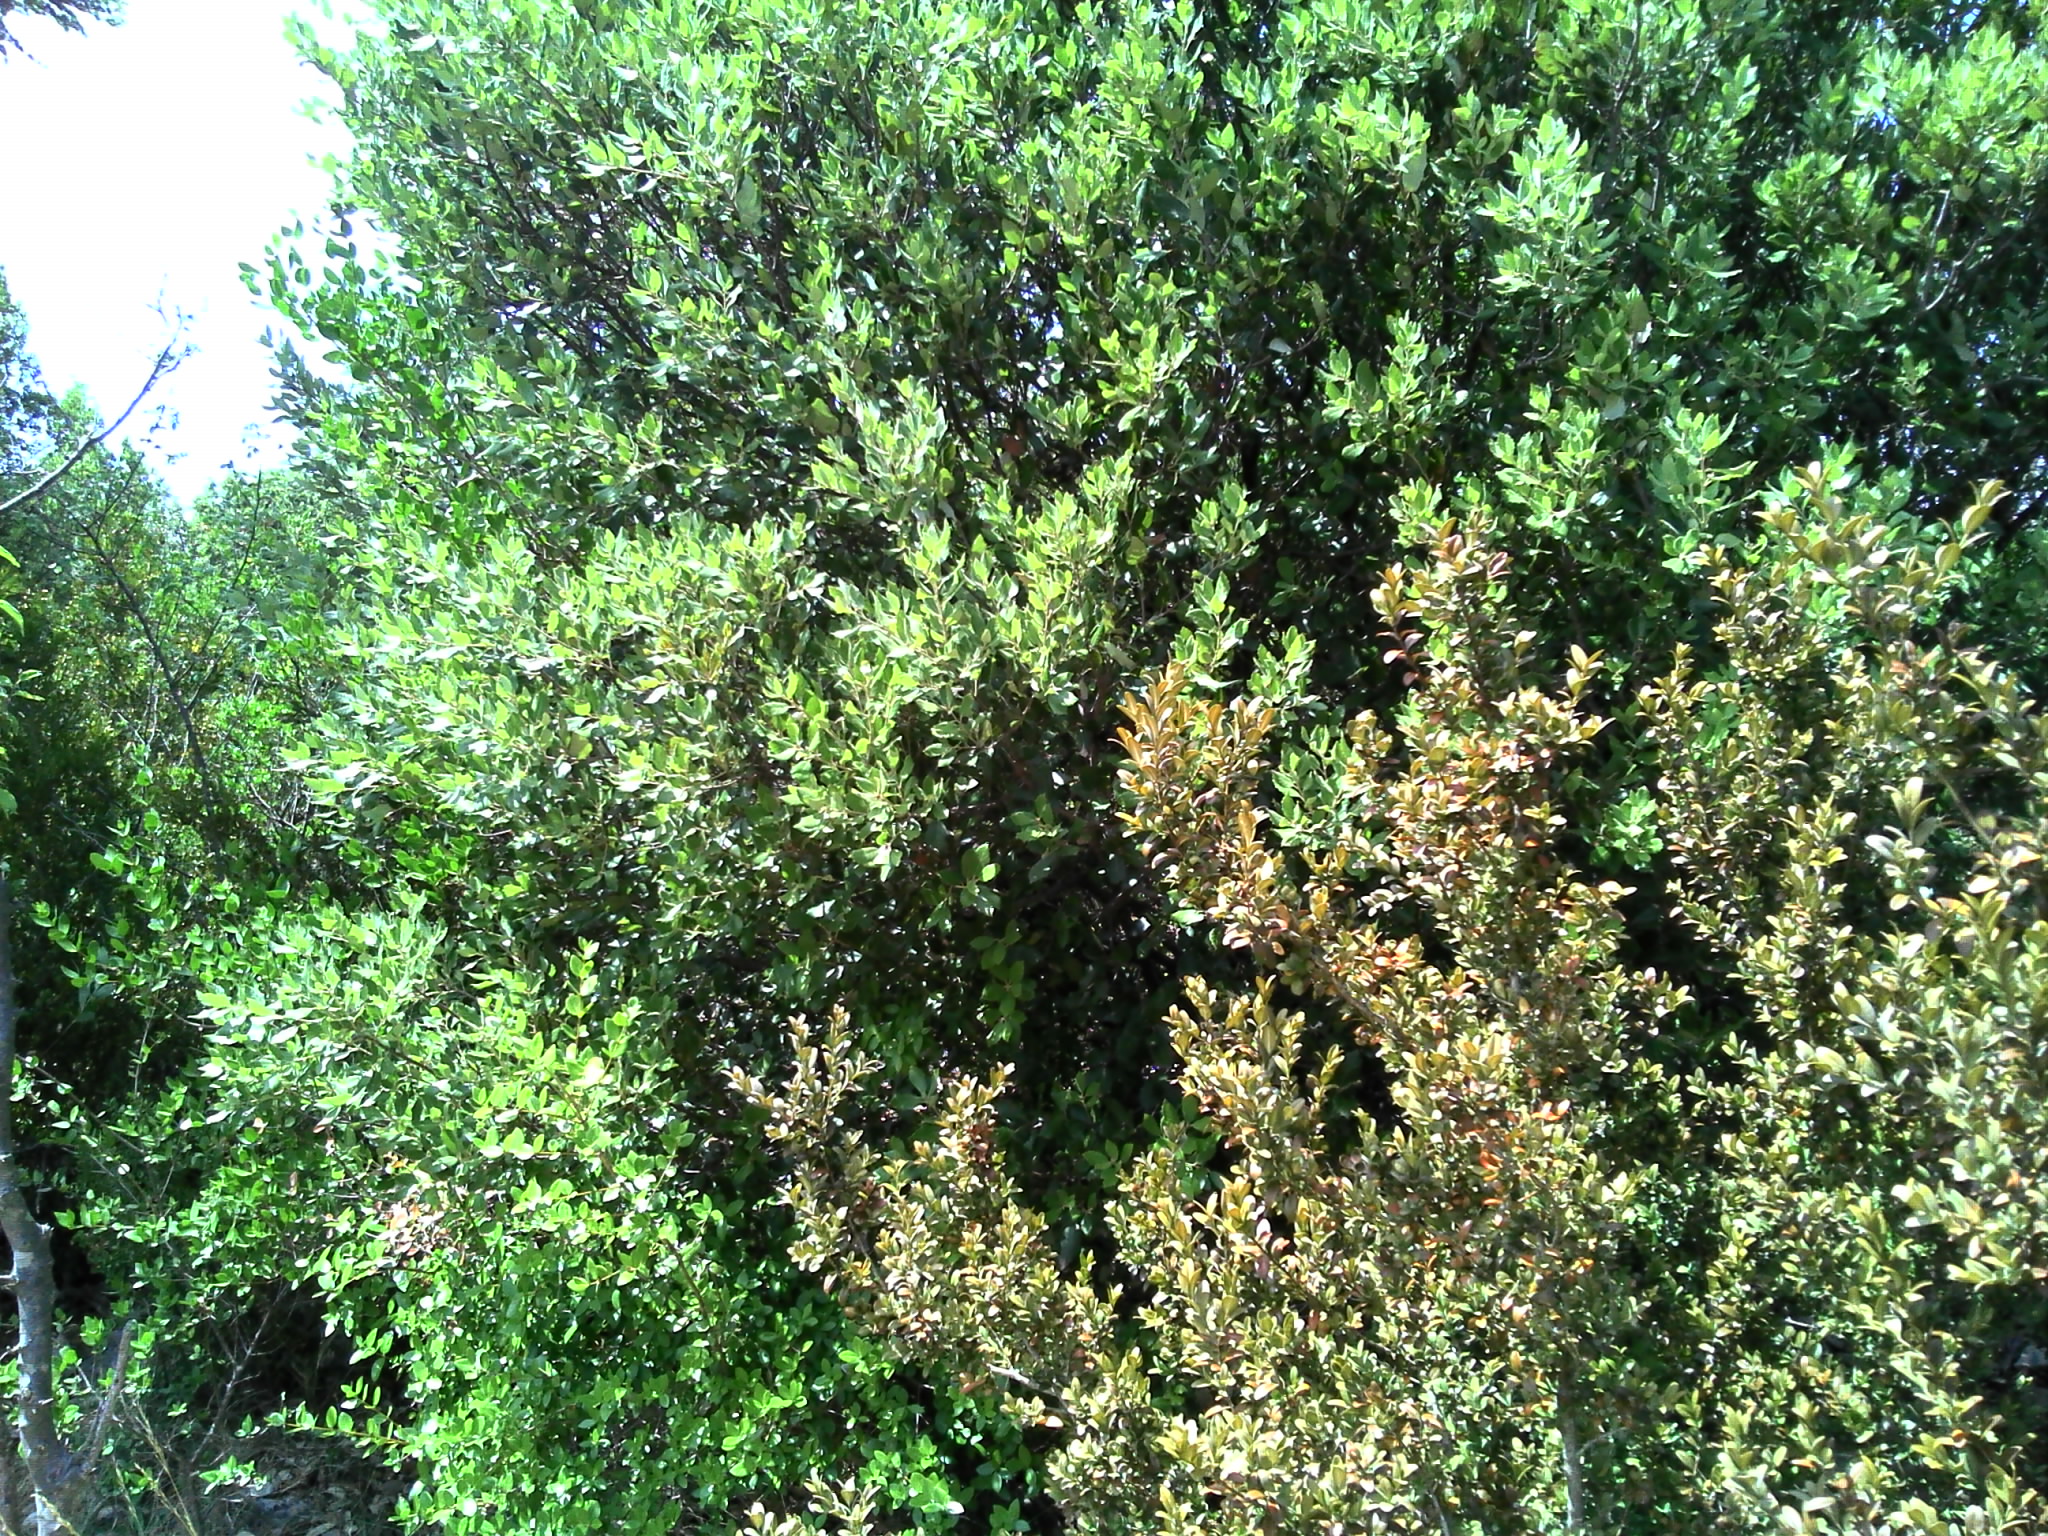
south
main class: Woodland
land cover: Other mixed woodland
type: broadleaved evergreen forest
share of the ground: 50 - 75 %
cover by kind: coniferous forest trees 35 %, broadleaved forest trees 35 %, herbaceous plants 15 %, unconsolidated bare surface 15 %
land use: Semi-natural and natural areas not in use
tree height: > 5 m
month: July
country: FR
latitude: 44.1034
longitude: 4.2987
